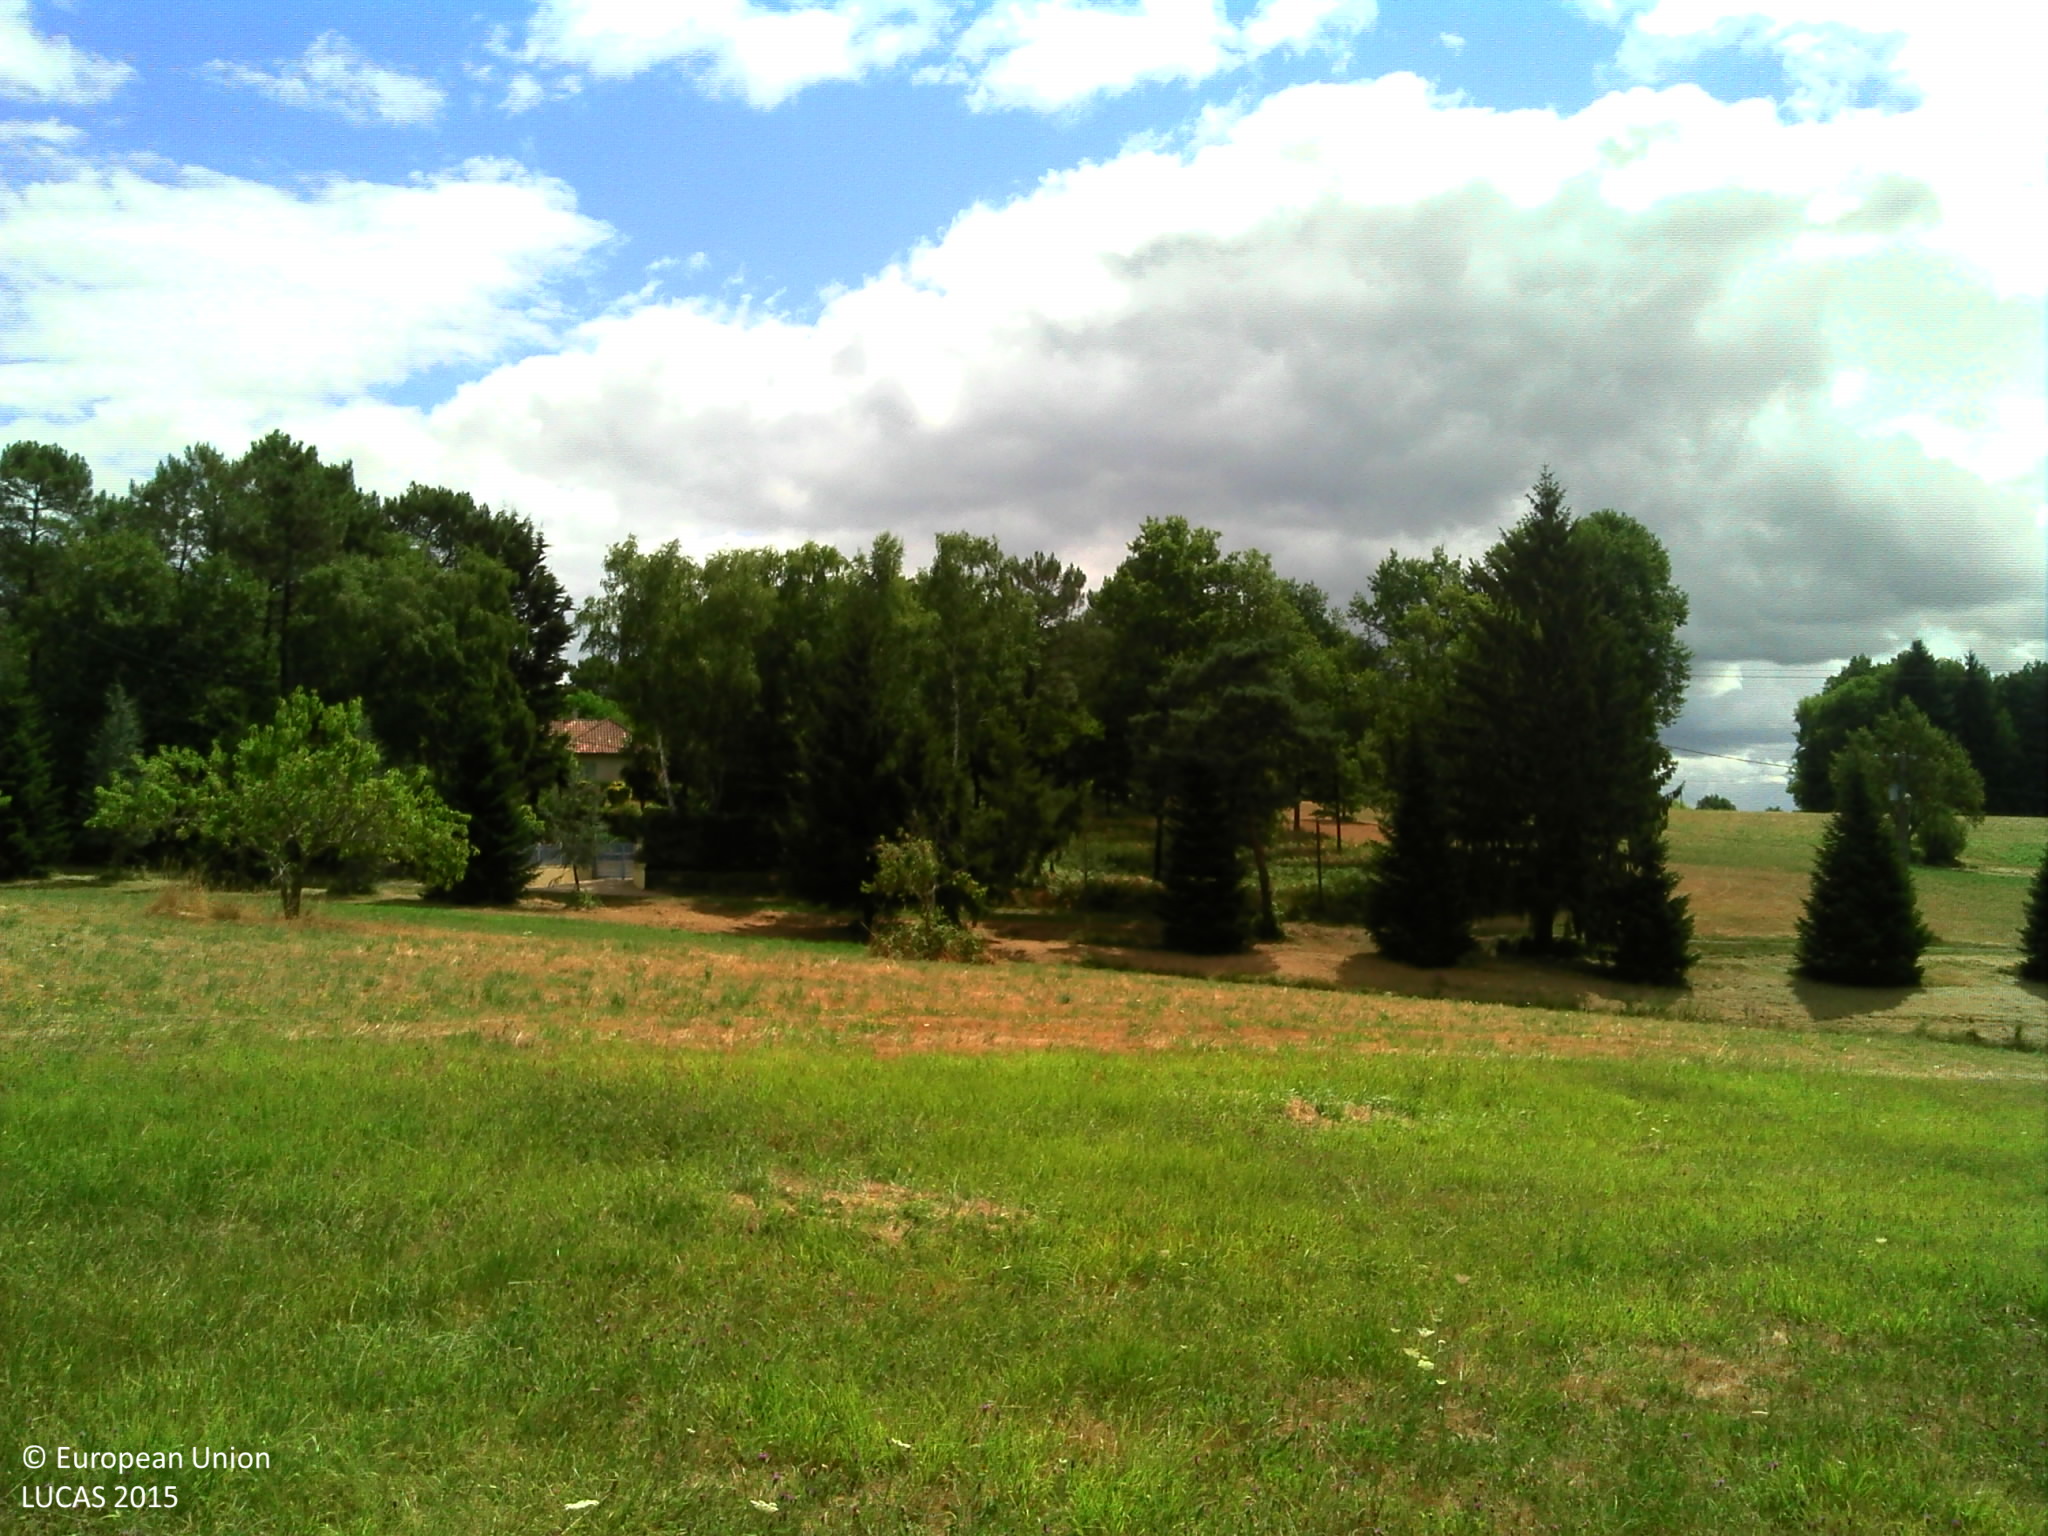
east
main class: Grassland
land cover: Grassland without tree/shrub cover
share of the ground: > 75 %
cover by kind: herbaceous plants 90 %, lichens and mosses 10 %
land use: Agriculture (excluding fallow land and kitchen gardens)
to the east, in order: Grassland without tree/shrub cover; Lines of trees; Grassland without tree/shrub cover; Paved roads, cycling and walking lanes; Ditches and canals; Electric lines; Spruce dominated mixed woodland; Grassland without tree/shrub cover; Spruce dominated mixed woodland
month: July
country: FR
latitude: 45.3472
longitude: 1.1216
